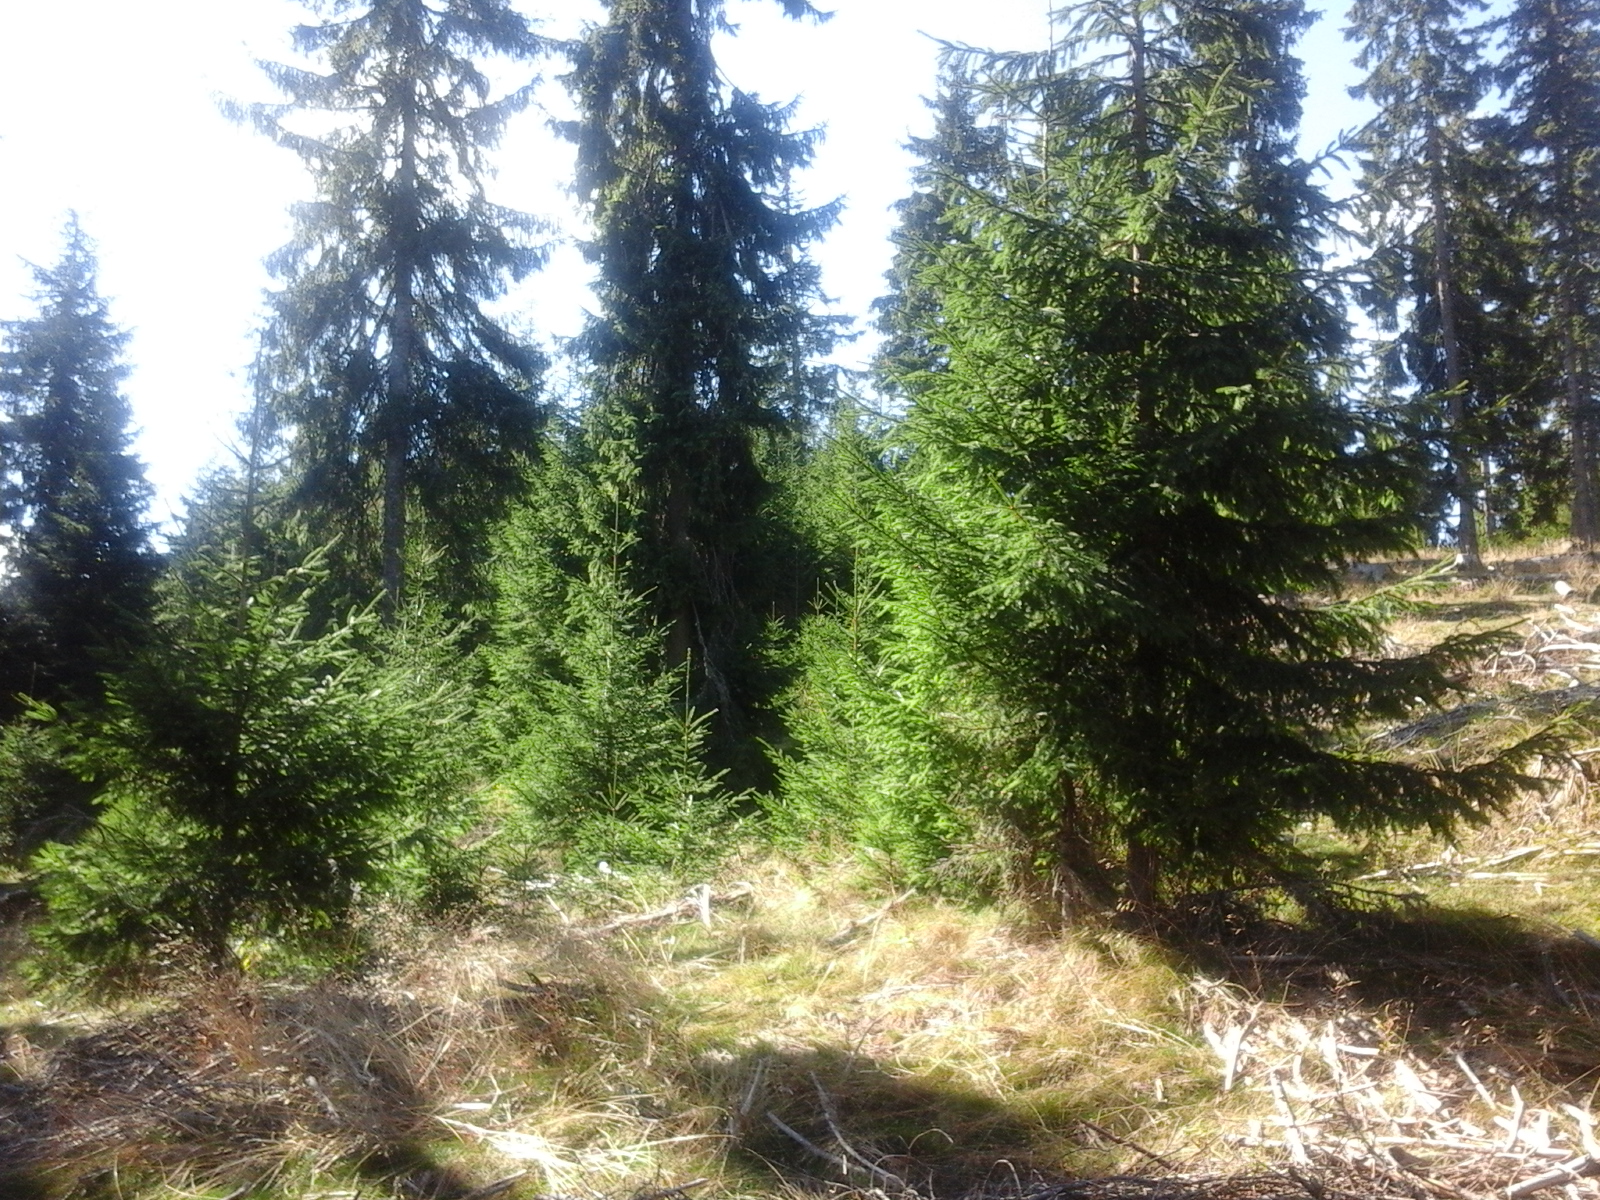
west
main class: Woodland
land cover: Spruce dominated coniferous woodland
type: alpine coniferous forest
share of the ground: > 75 %
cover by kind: coniferous forest trees 100 %
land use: Forestry
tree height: > 5 m
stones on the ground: 25 - 50 %
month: October
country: RO
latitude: 46.5407
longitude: 22.9818
